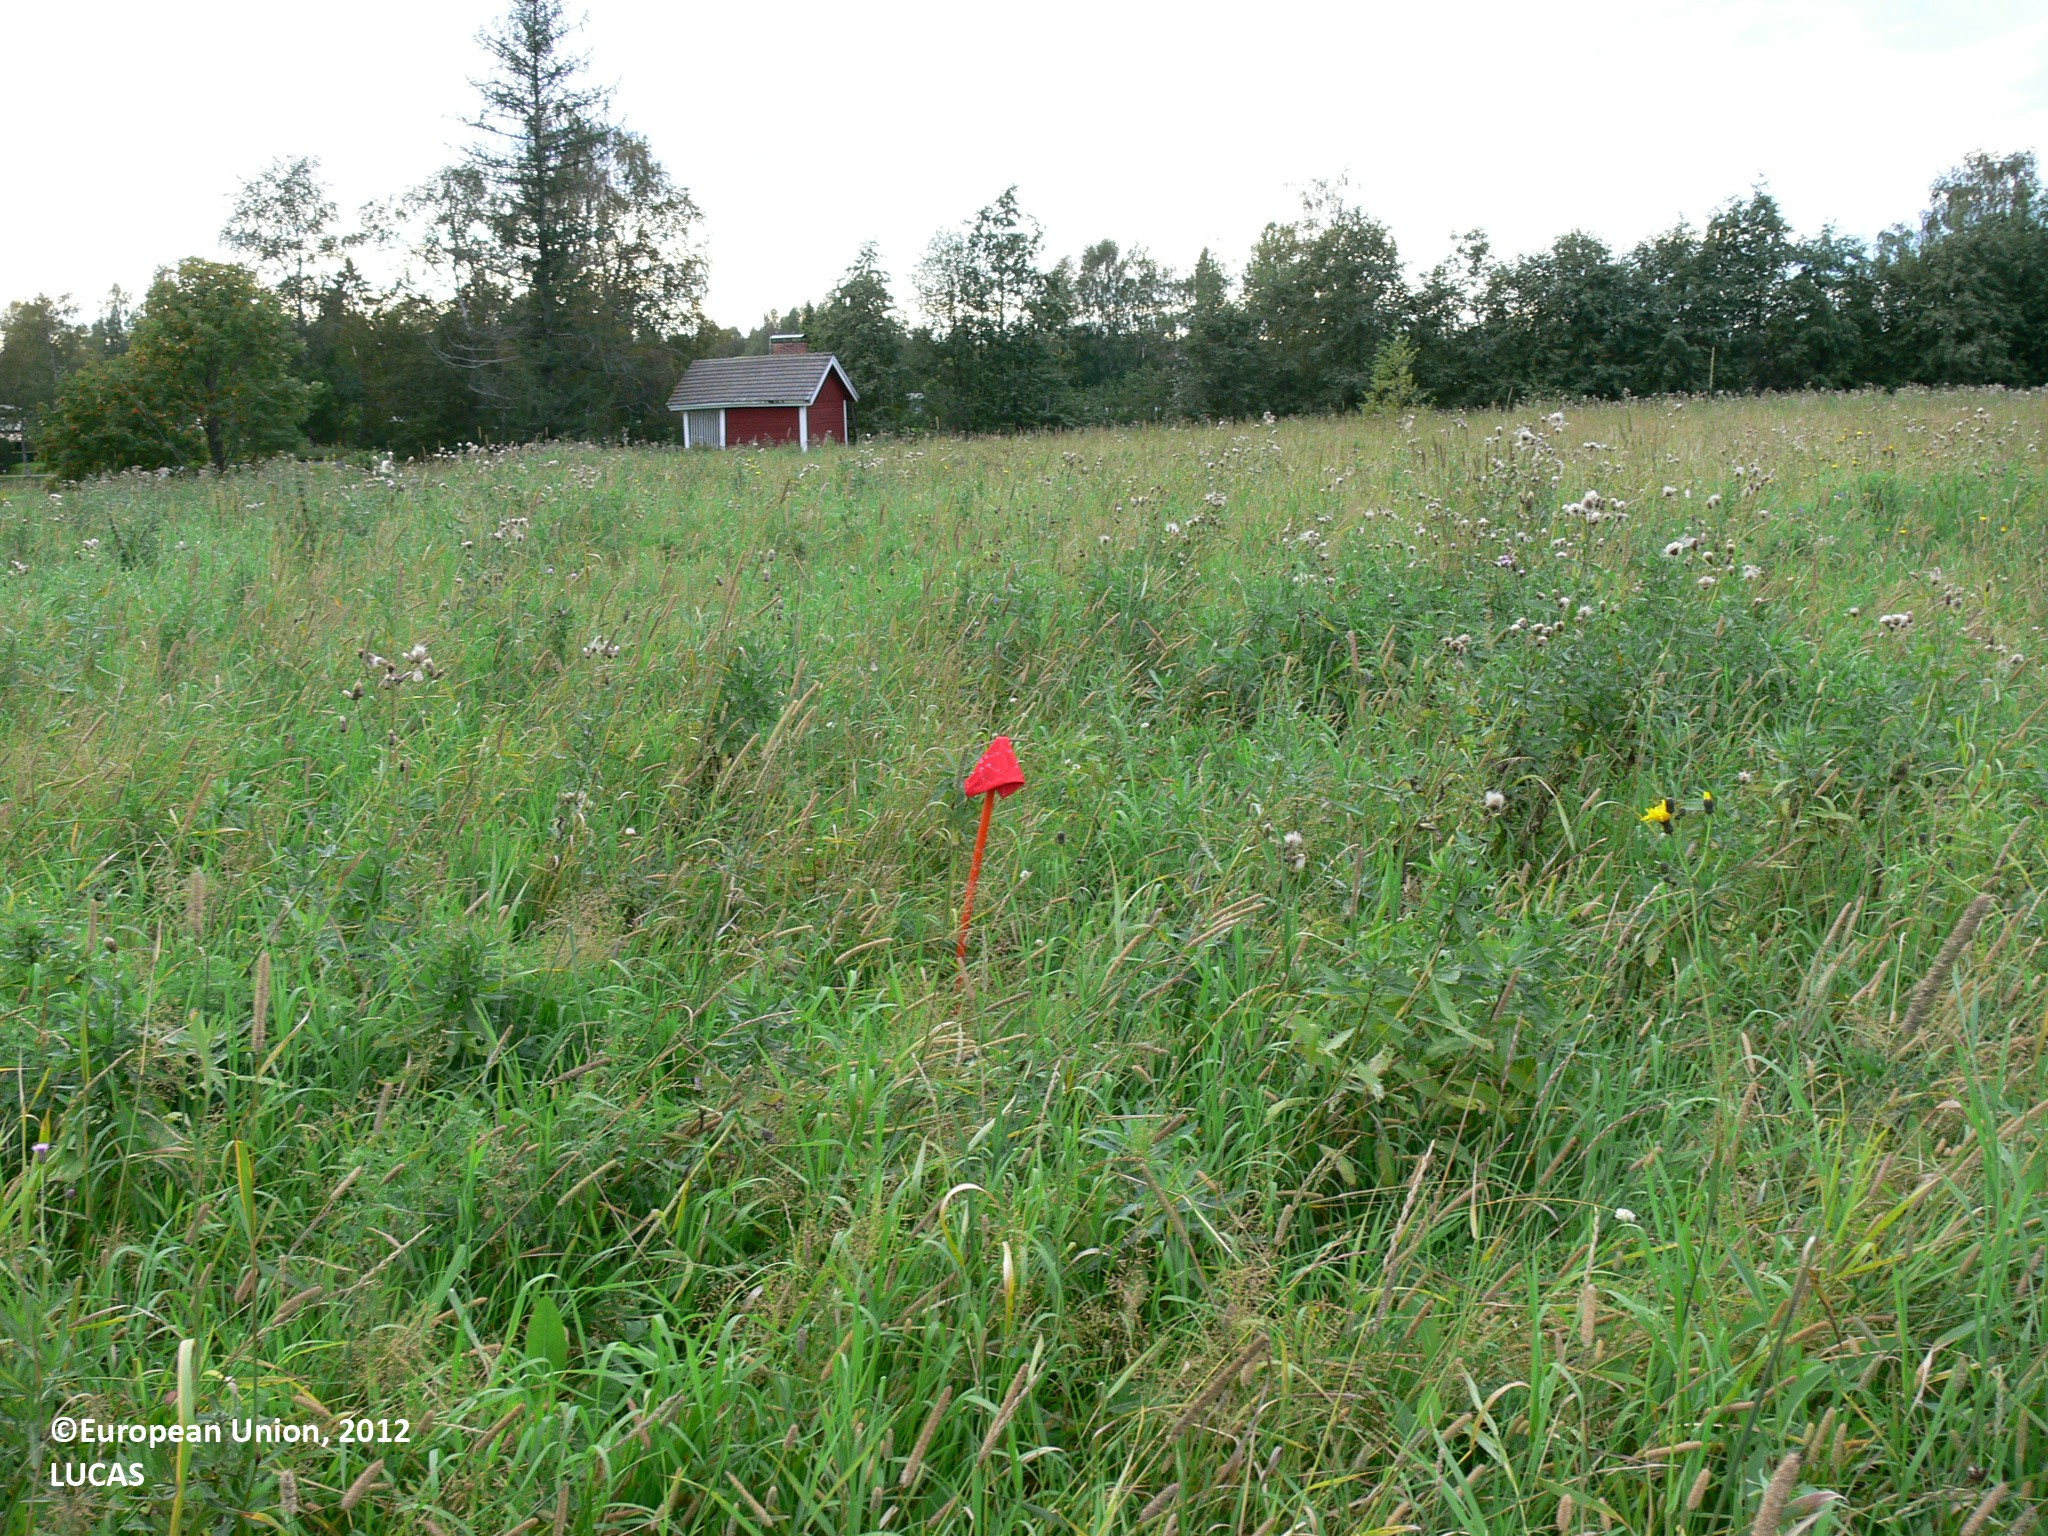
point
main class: Grassland
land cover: Spontaneously vegetated surfaces
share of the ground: > 75 %
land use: Fallow land
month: August
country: FI
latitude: 63.3220
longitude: 30.0358
